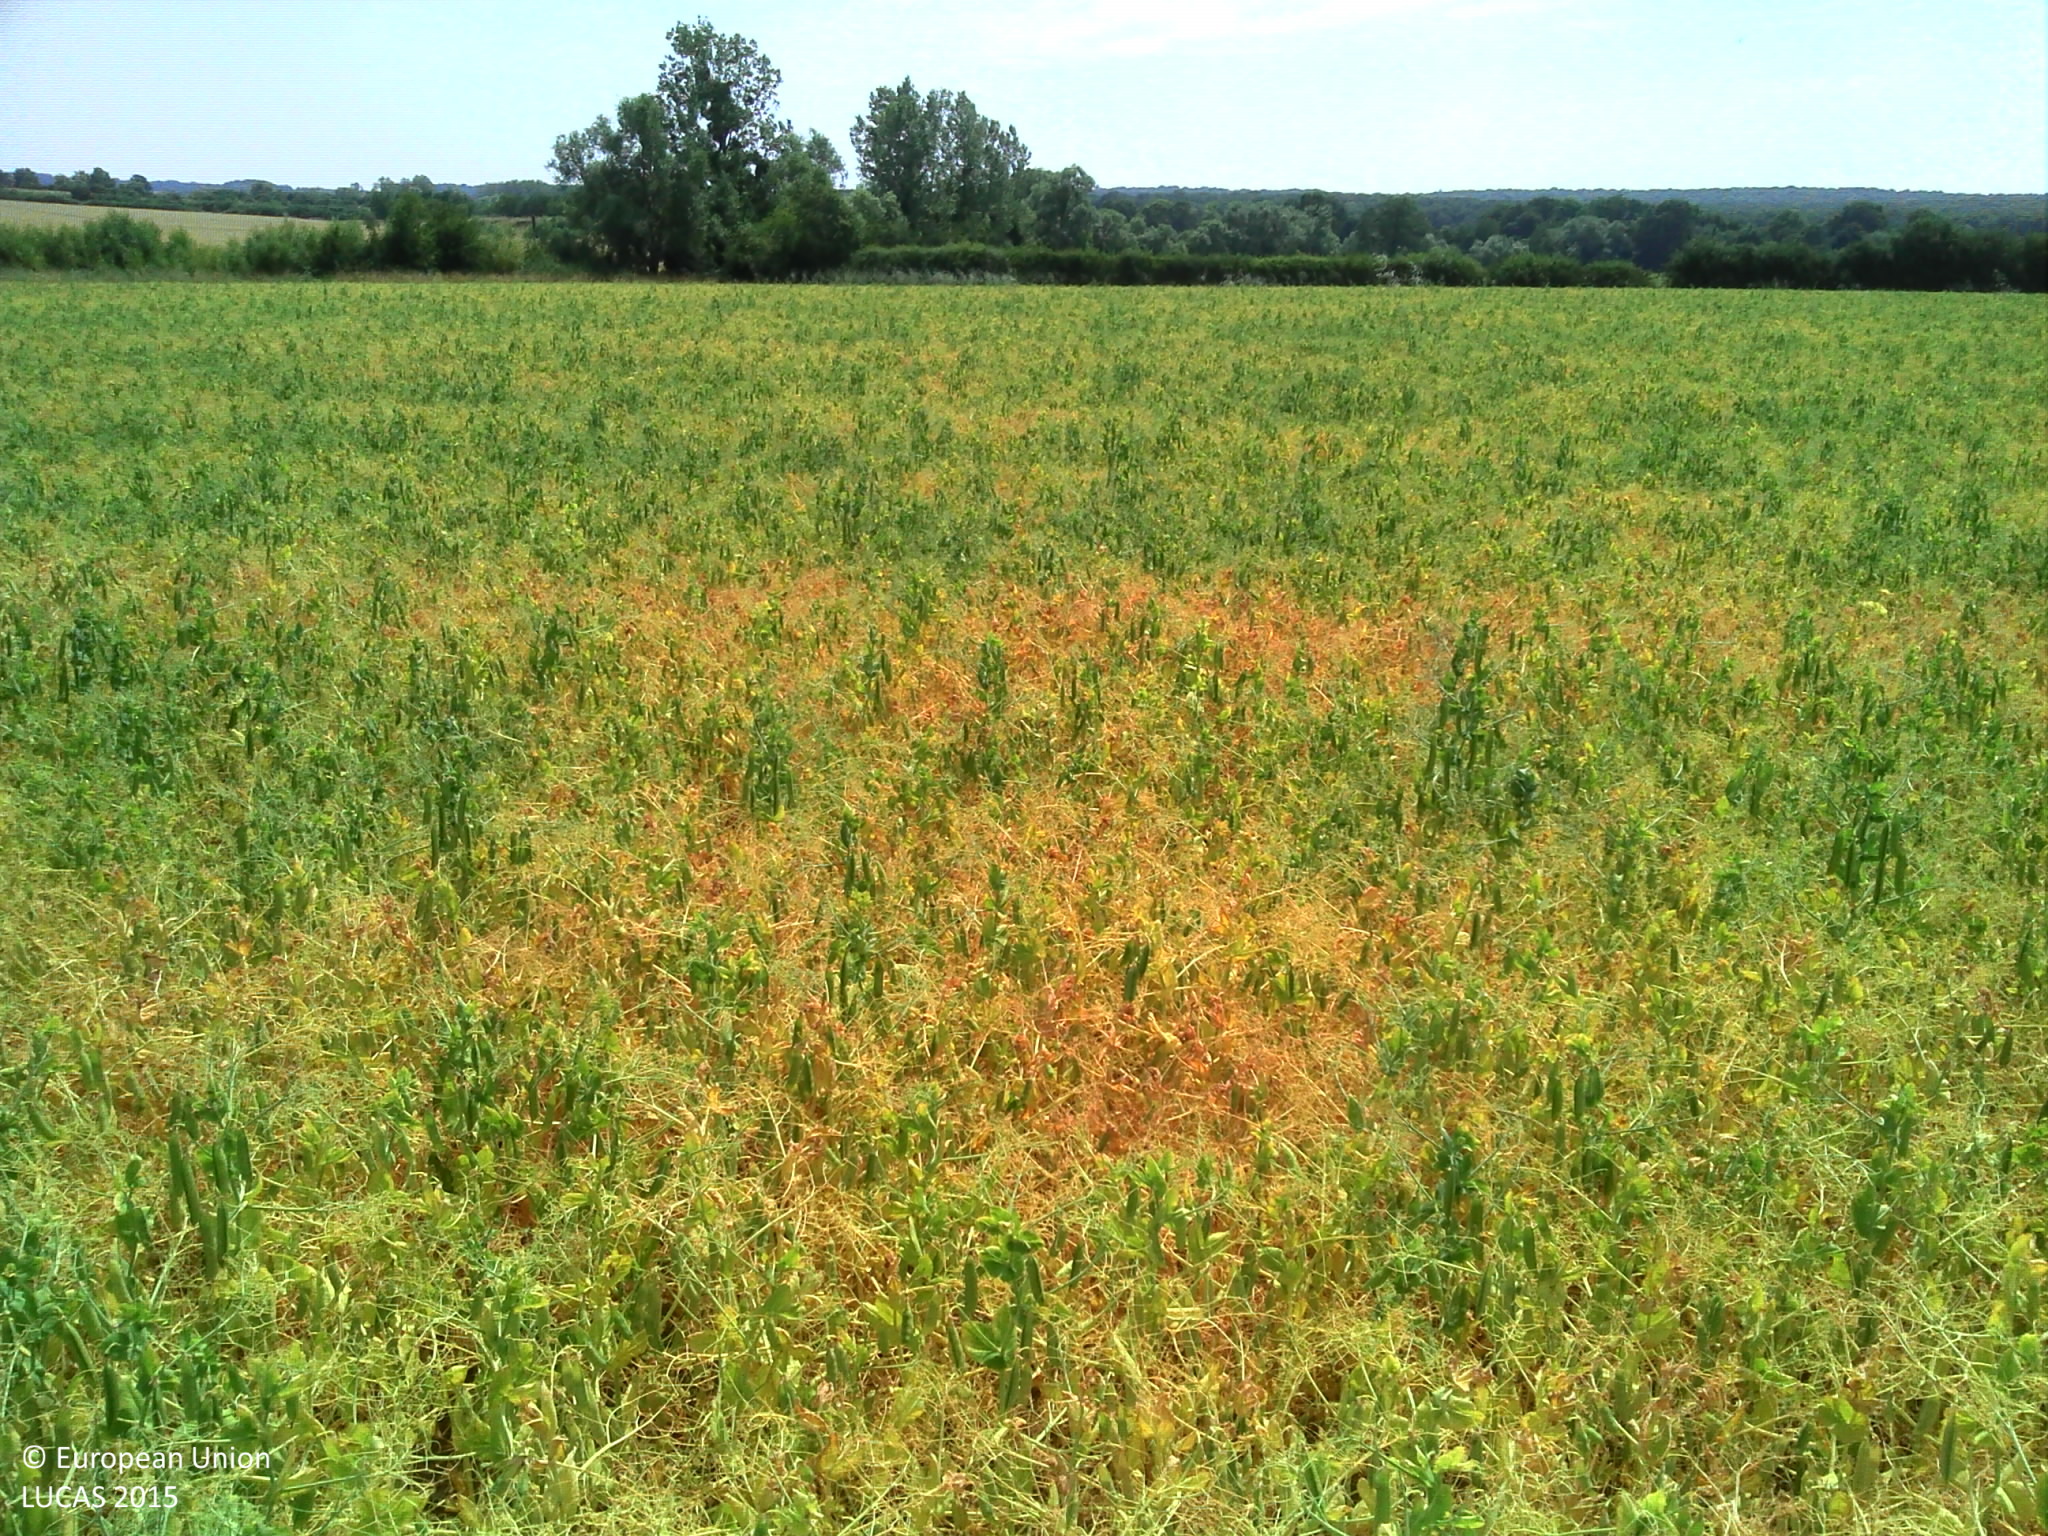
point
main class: Cropland
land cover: Dry pulses
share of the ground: > 75 %
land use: Agriculture (excluding fallow land and kitchen gardens)
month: July
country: FR
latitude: 48.6090
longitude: 6.2161
